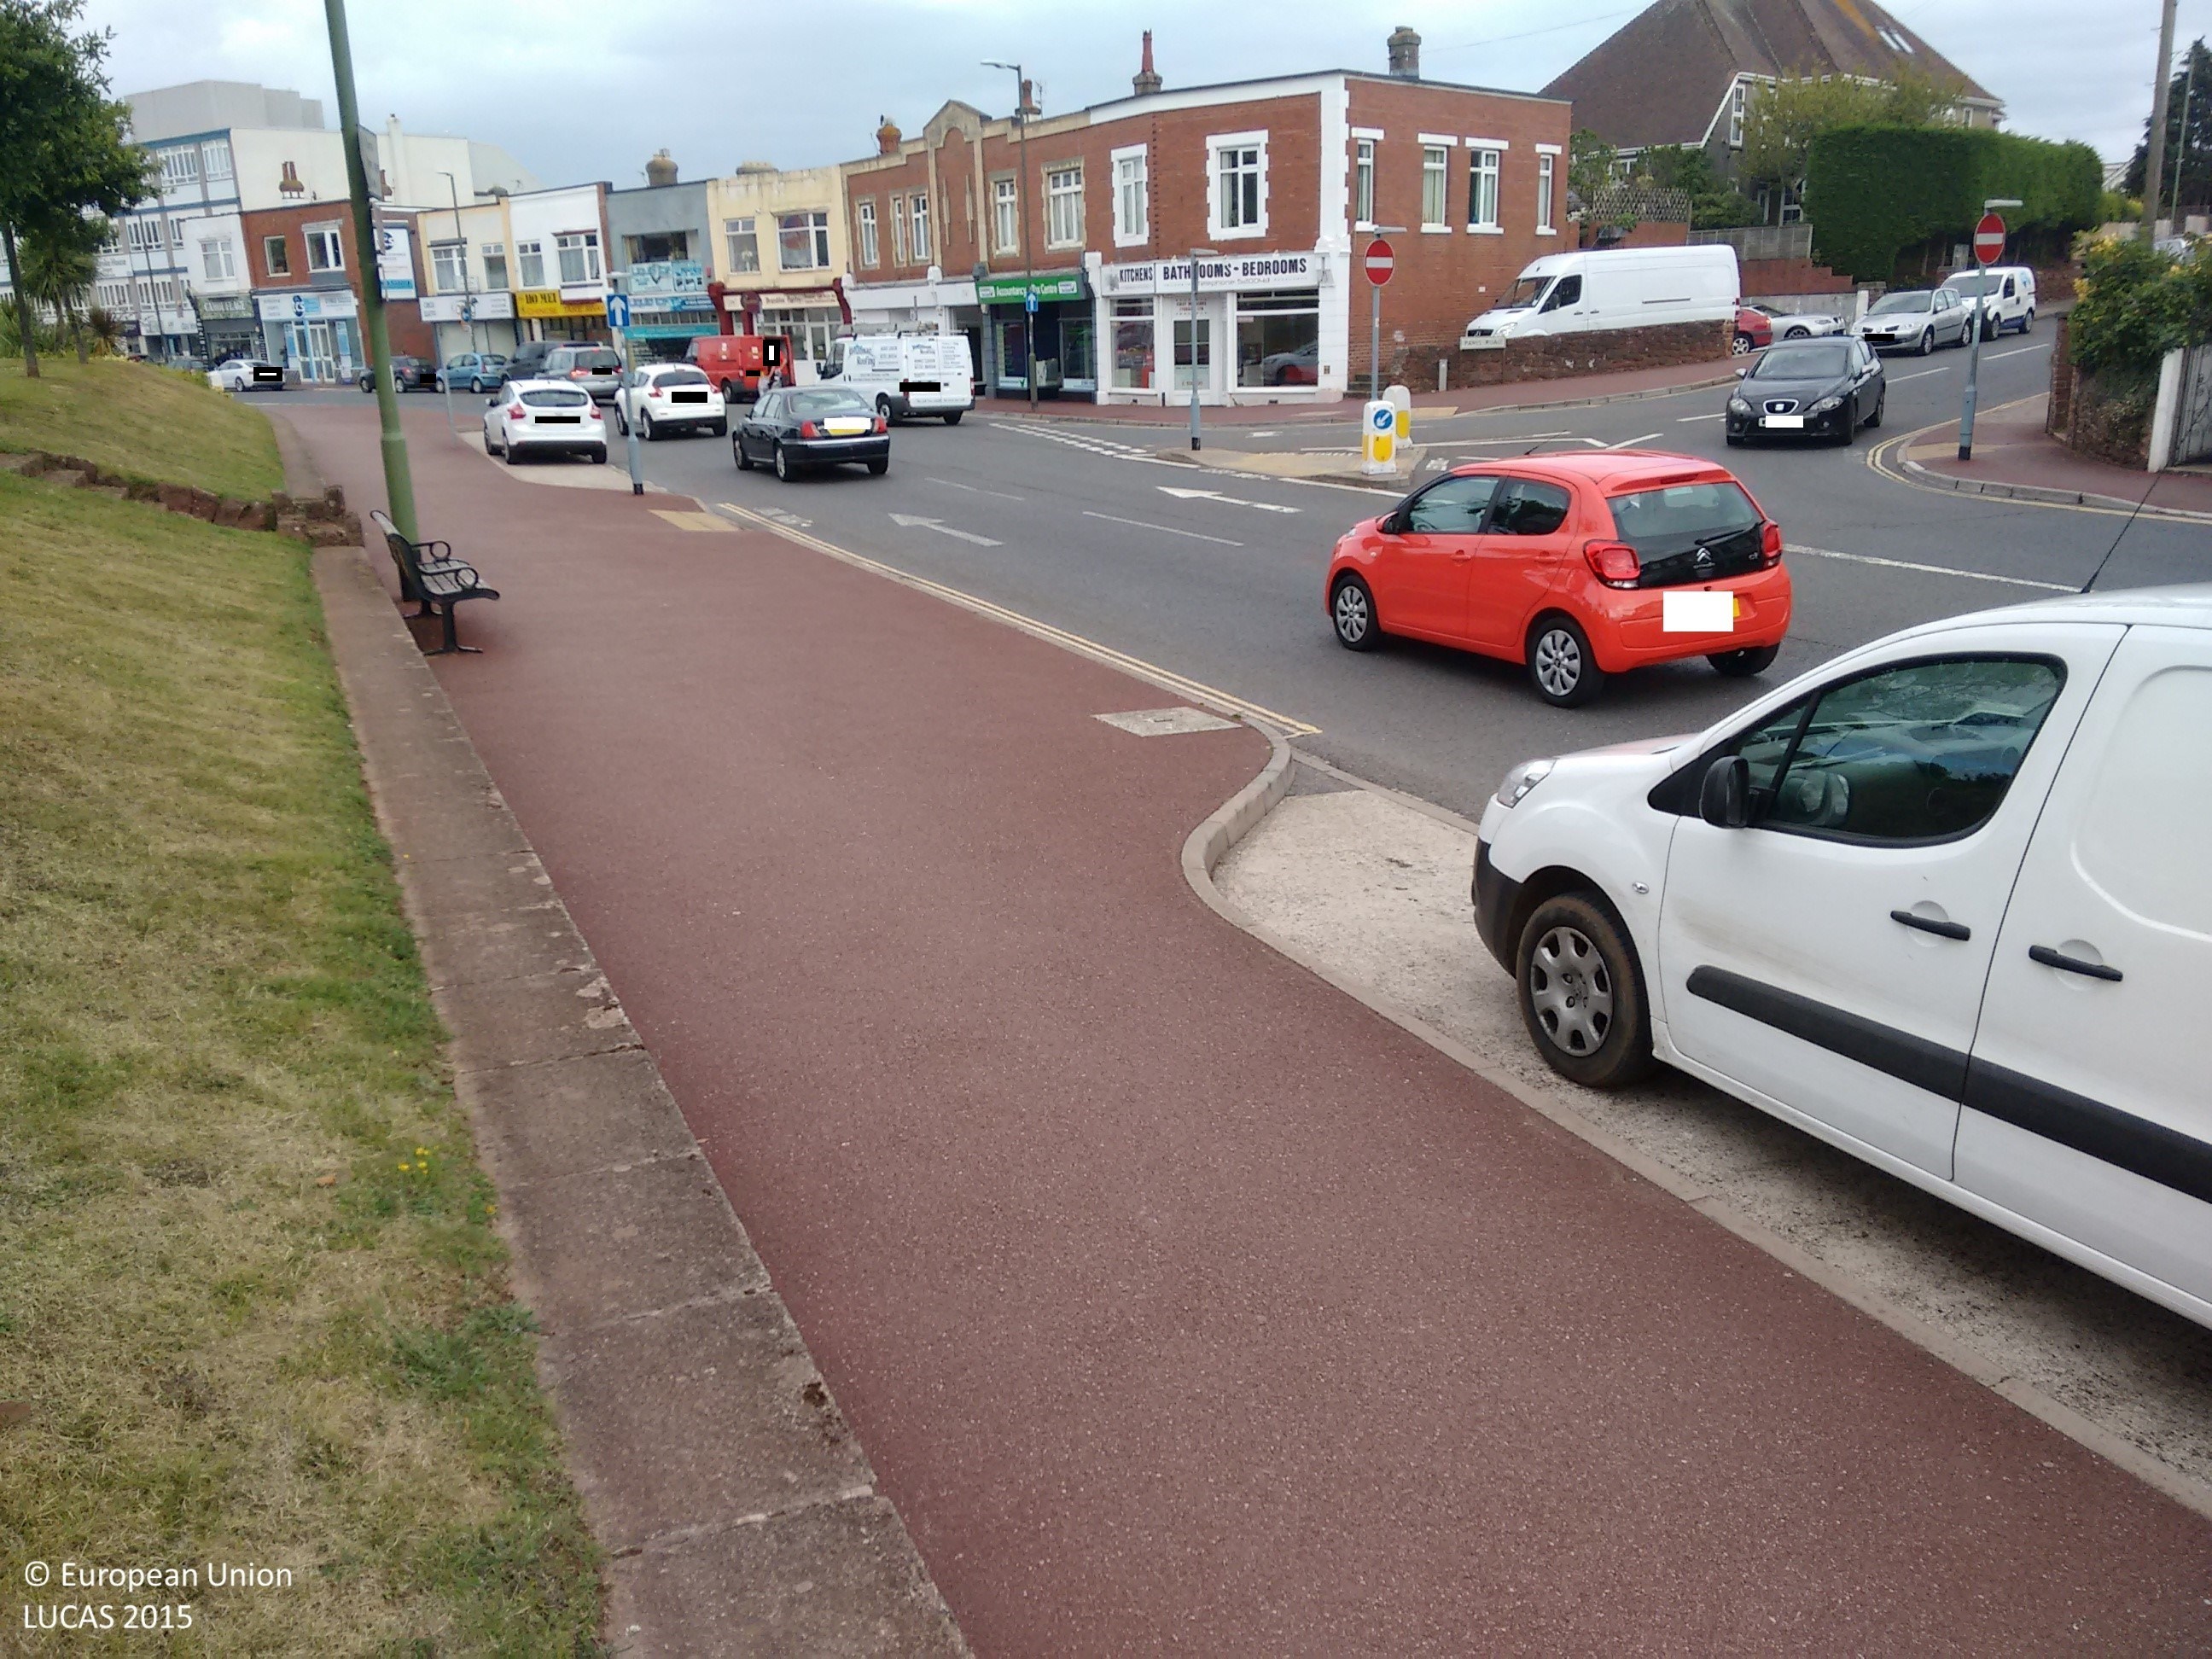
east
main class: Grassland
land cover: Grassland with sparse tree/shrub cover
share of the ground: > 75 %
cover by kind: herbaceous plants 95 %, broadleaved forest trees 5 %
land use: Amenities, museums, leisure
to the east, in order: Grassland with sparse tree/shrub cover; Artificial constructions in urban areas
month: July
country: GB
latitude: 50.4453
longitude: -3.5613
